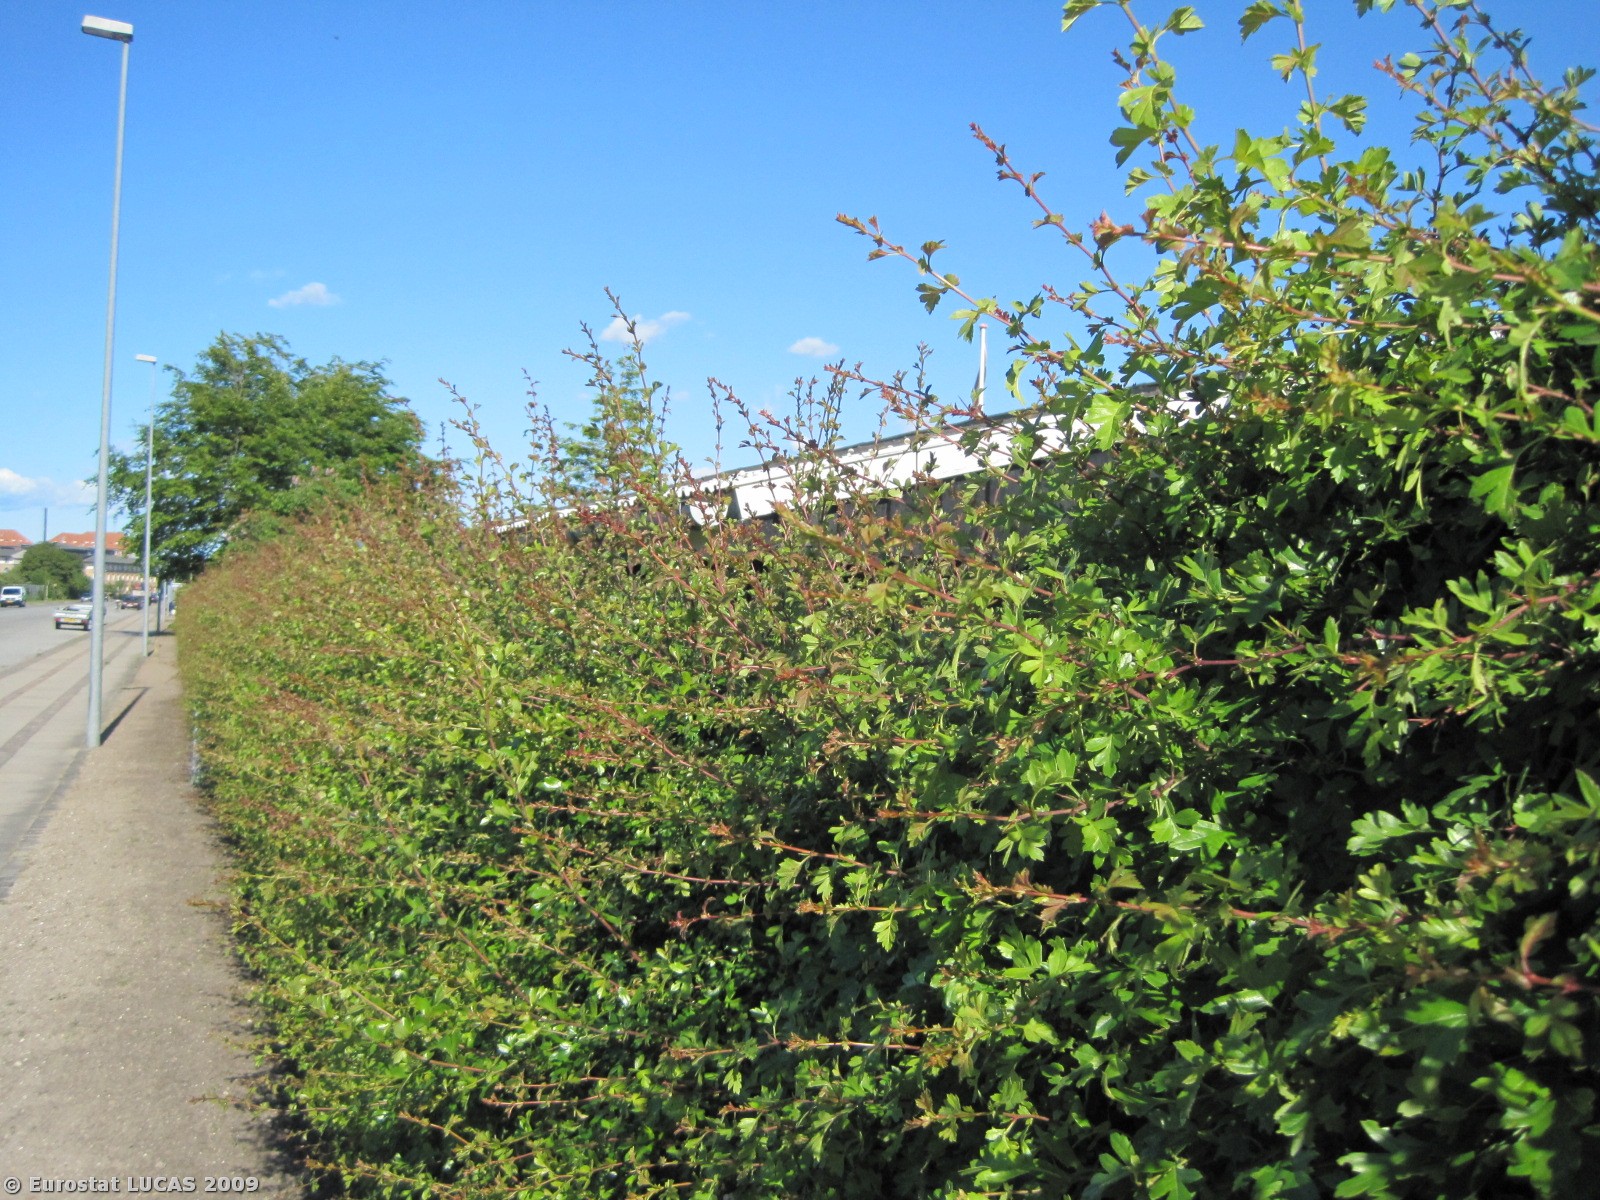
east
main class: Shrubland
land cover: Shrubland with sparse tree cover
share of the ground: > 75 %
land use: Residential
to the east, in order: Shrubland with sparse tree cover; Artificial constructions in urban areas
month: June
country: DK
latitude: 57.0506
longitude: 9.8848
